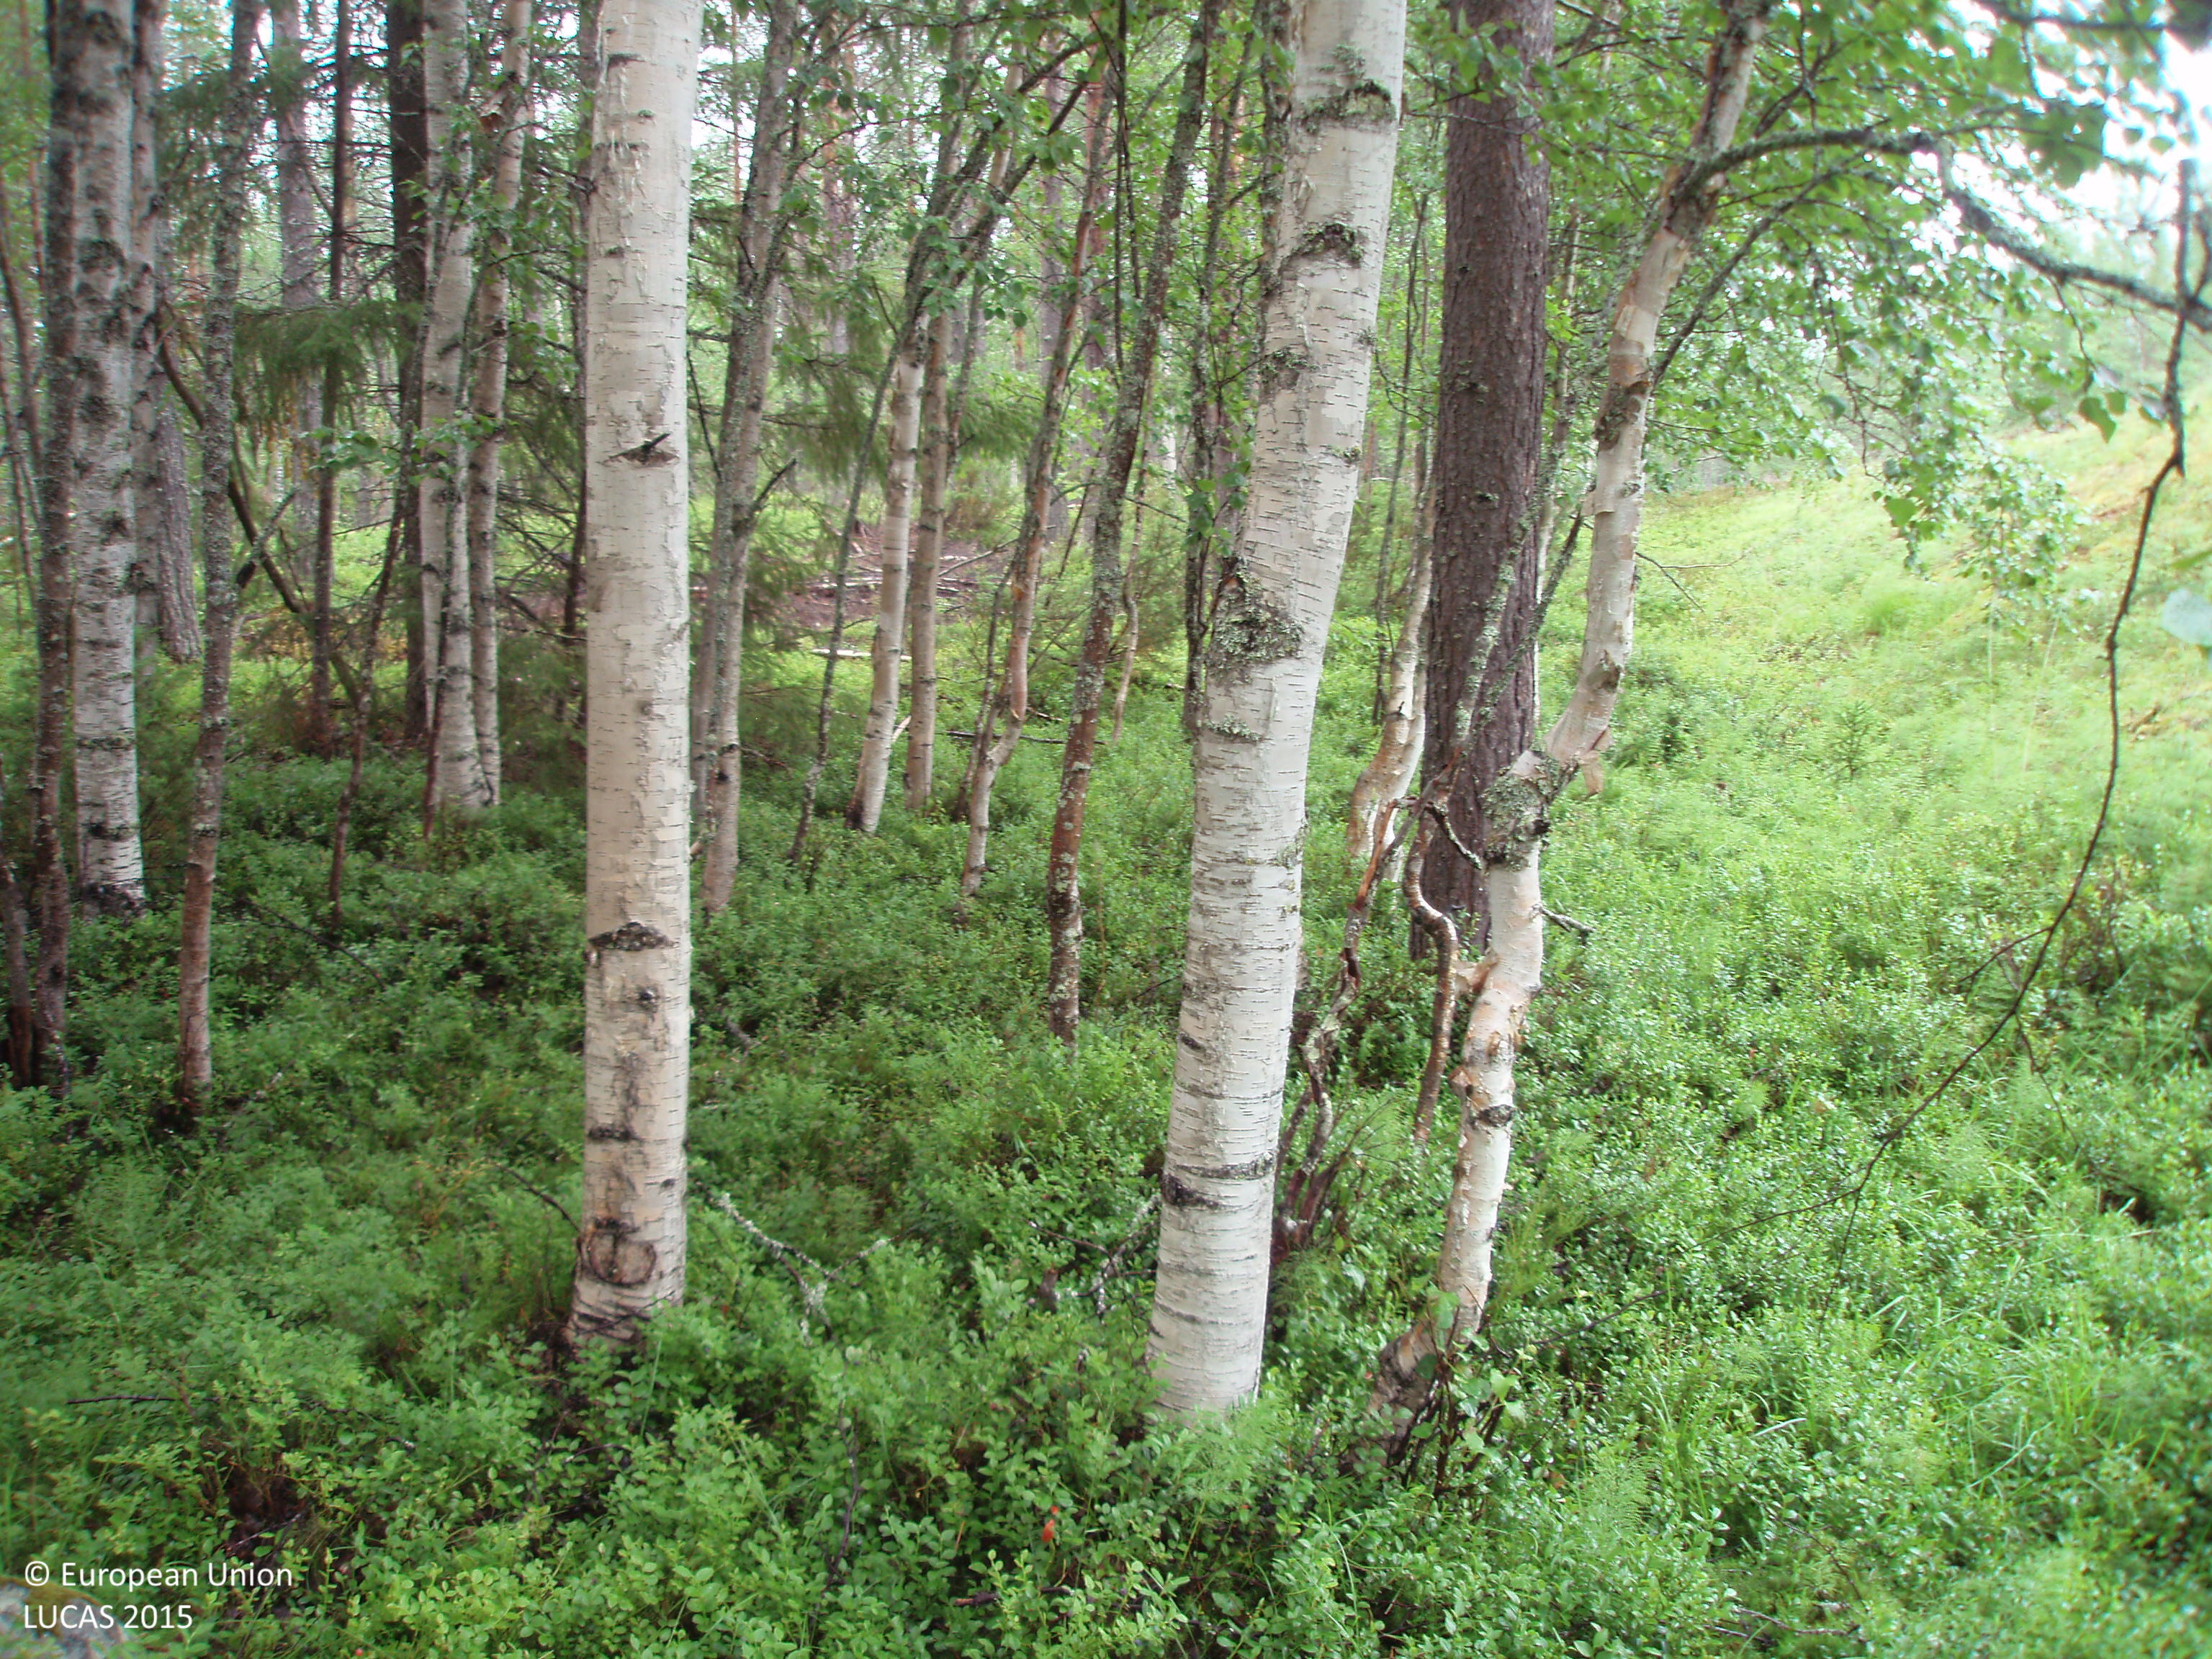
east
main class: Woodland
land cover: Broadleaved woodland
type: boreal forest
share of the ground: > 75 %
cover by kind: broadleaved forest trees 85 %, shrubs 10 %, coniferous forest trees 5 %
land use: Forestry
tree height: > 5 m
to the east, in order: Broadleaved woodland; Pine dominated coniferous woodland; Tracks; Pine dominated coniferous woodland; Pine dominated mixed woodland; Ditches and canals; Pine dominated mixed woodland; Pine dominated coniferous woodland
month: August
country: FI
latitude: 65.5879
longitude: 27.5416
